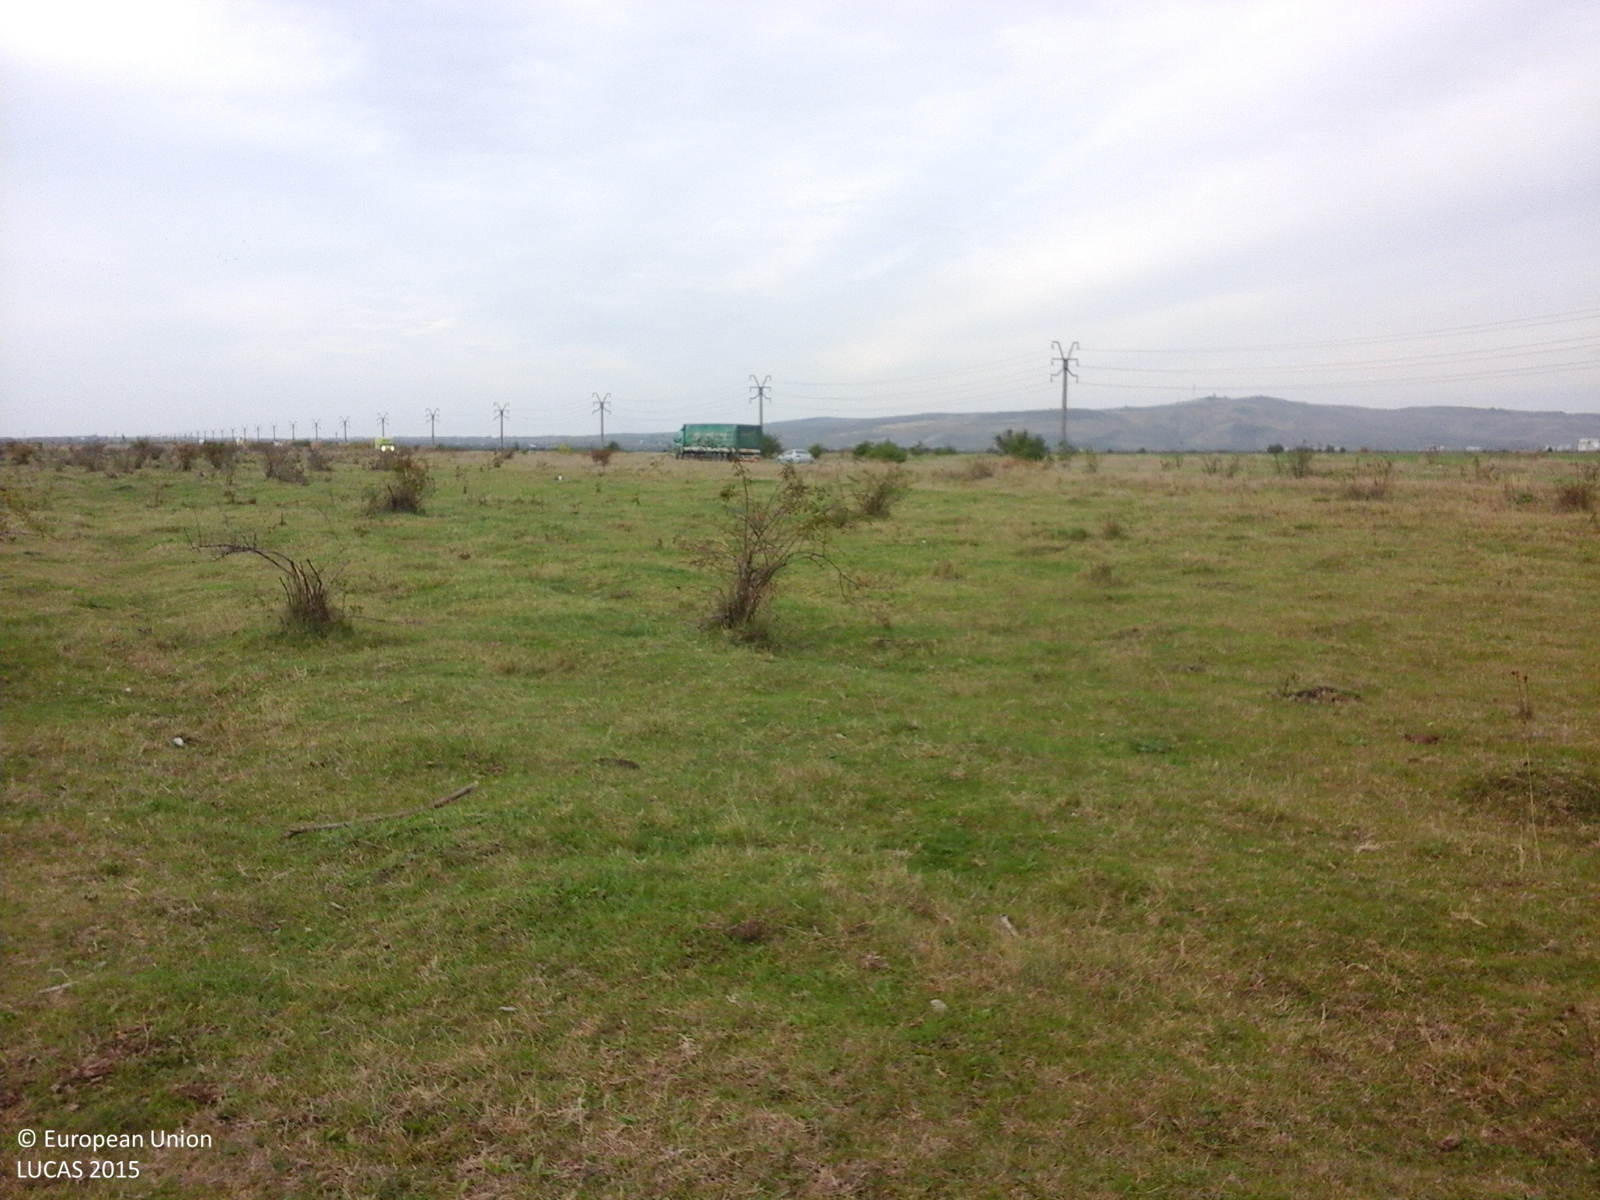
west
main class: Grassland
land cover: Grassland without tree/shrub cover
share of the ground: > 75 %
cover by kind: herbaceous plants 100 %
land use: Agriculture (excluding fallow land and kitchen gardens)
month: October
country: RO
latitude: 44.9648
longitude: 26.2794
